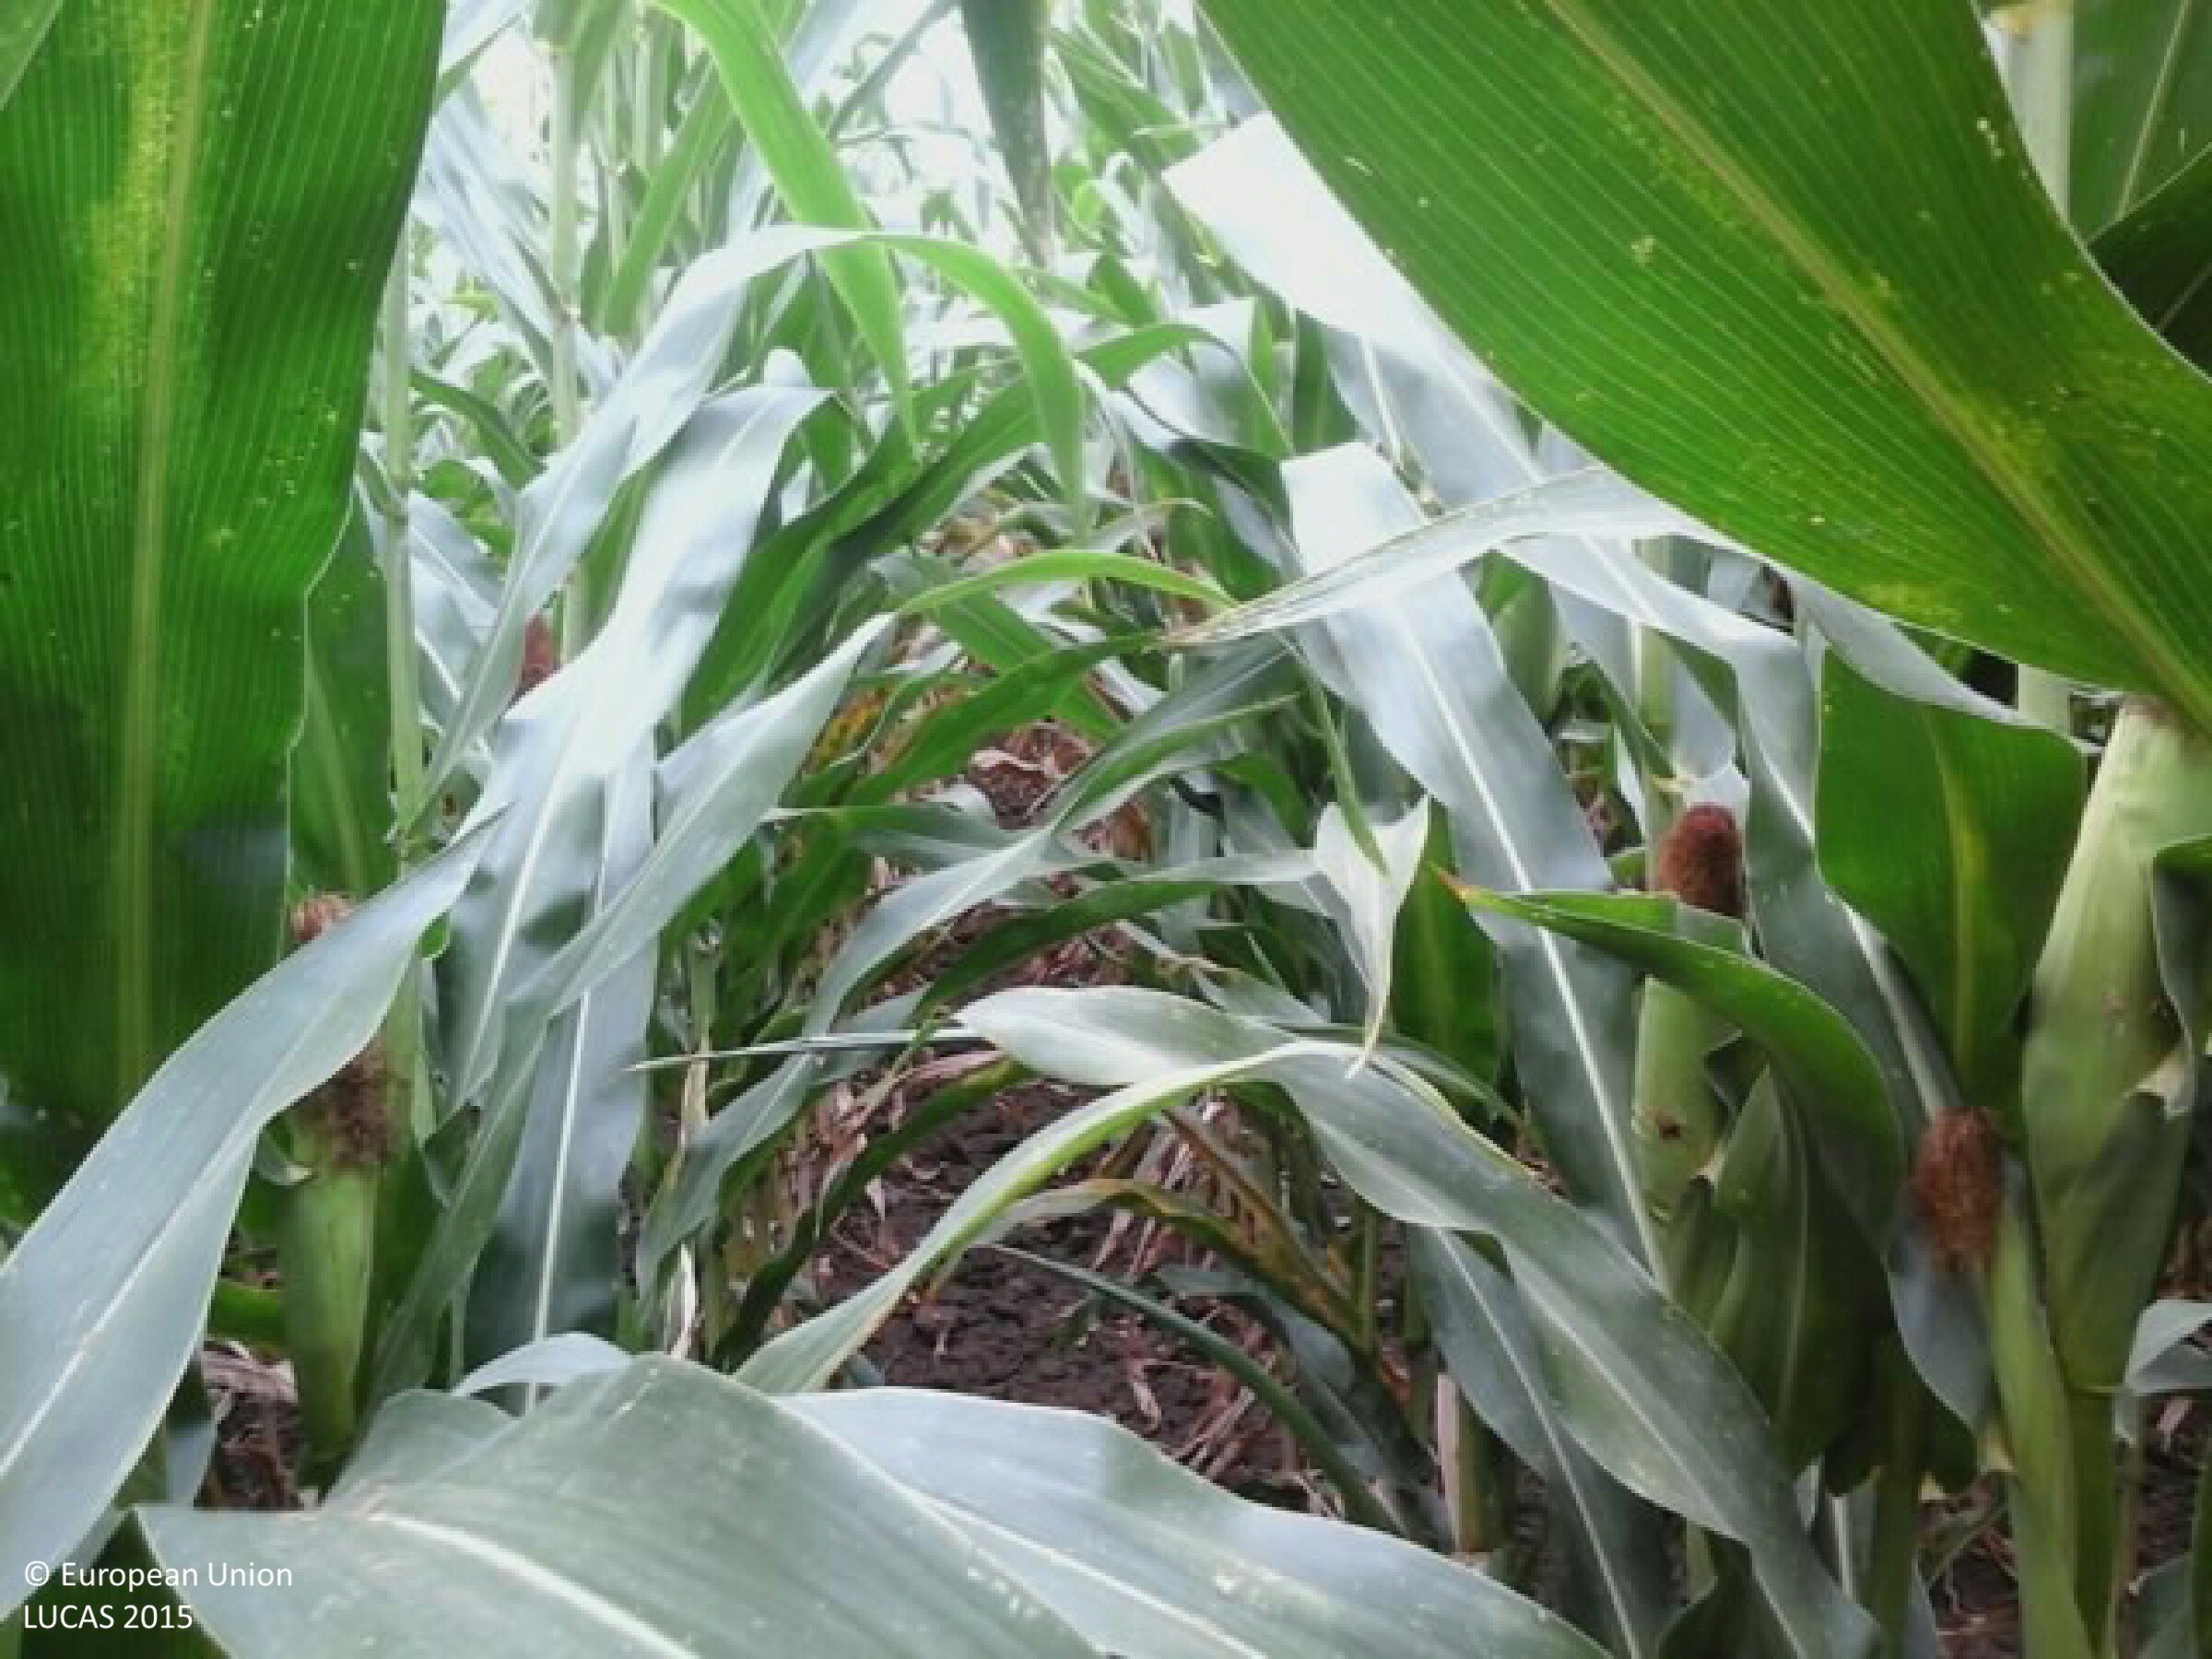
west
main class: Cropland
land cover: Maize
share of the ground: > 75 %
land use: Agriculture (excluding fallow land and kitchen gardens)
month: July
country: HU
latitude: 45.9370
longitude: 18.9751
